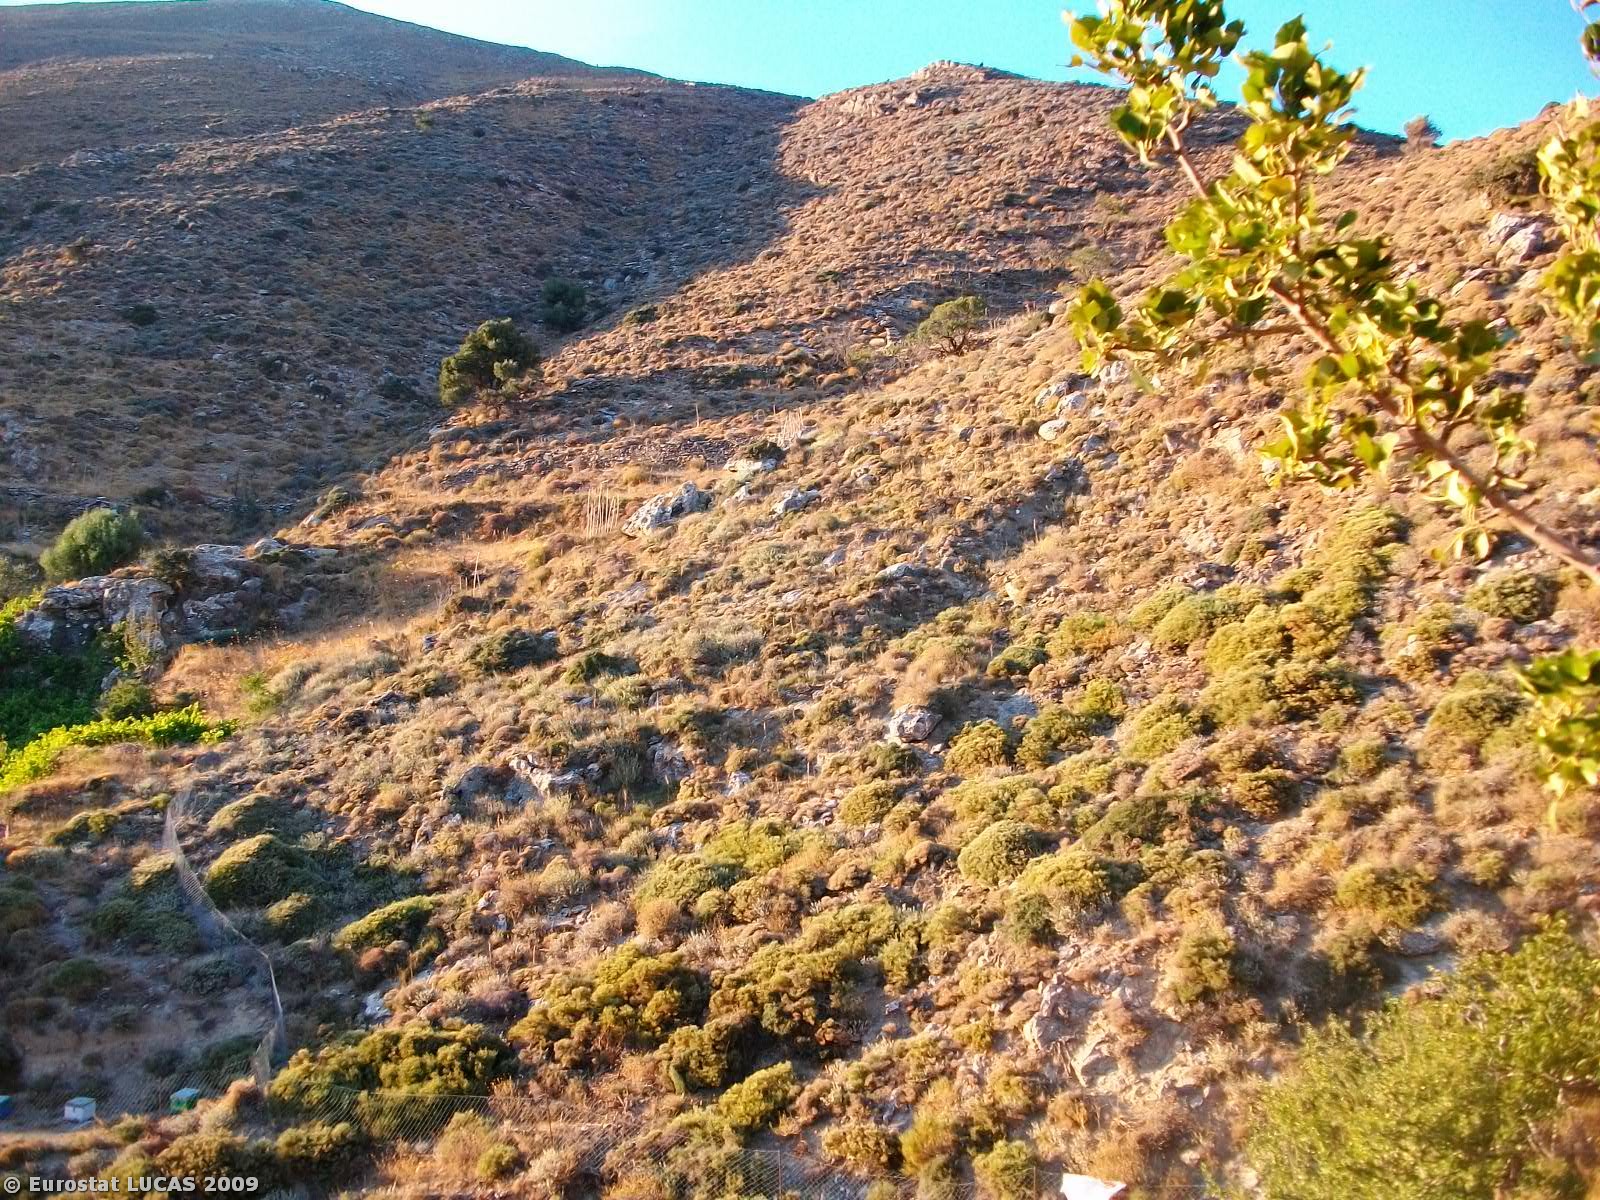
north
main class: Shrubland
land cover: Shrubland with sparse tree cover
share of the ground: > 75 %
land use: Nature reserves
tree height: < 5 m
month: August
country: GR
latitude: 35.0879
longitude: 25.9127
